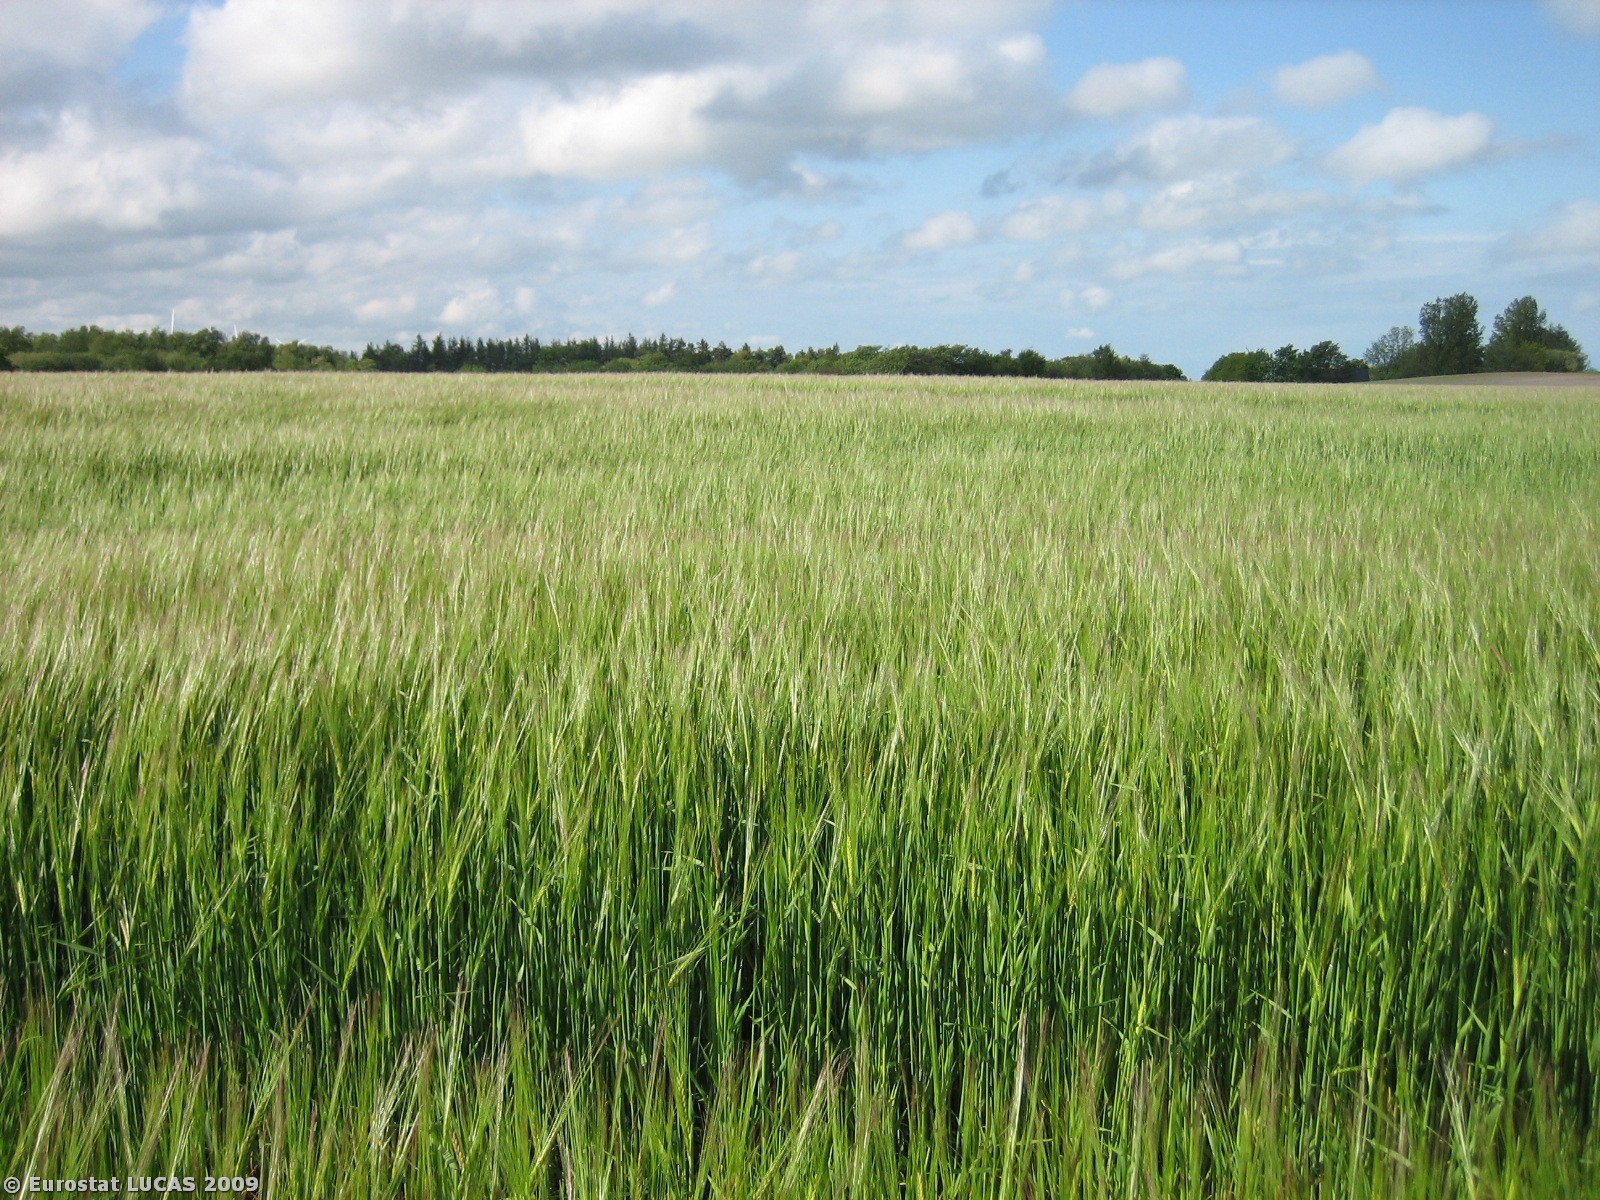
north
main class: Cropland
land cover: Barley
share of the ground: > 75 %
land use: Agriculture (excluding fallow land and kitchen gardens)
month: May
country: DK
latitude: 56.1814
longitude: 8.7287
